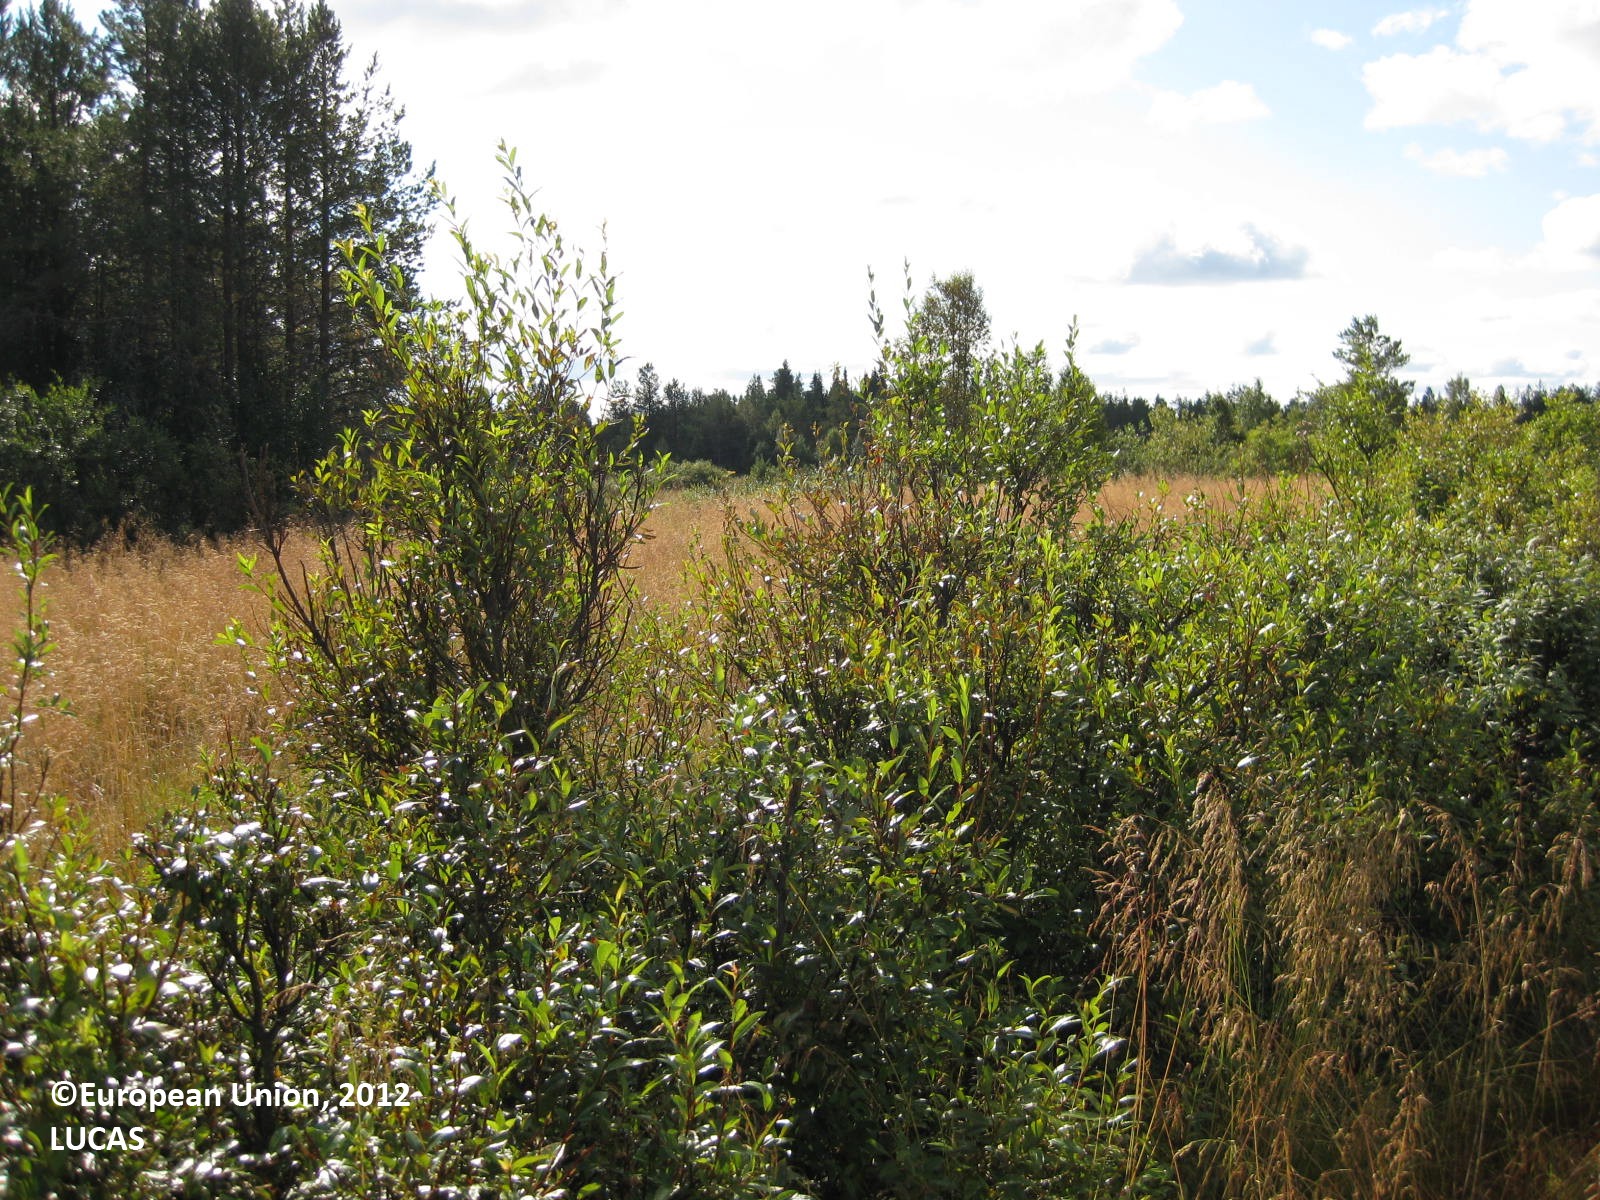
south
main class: Grassland
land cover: Grassland without tree/shrub cover
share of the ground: > 75 %
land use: Fallow land
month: August
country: FI
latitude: 66.3088
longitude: 28.9668
